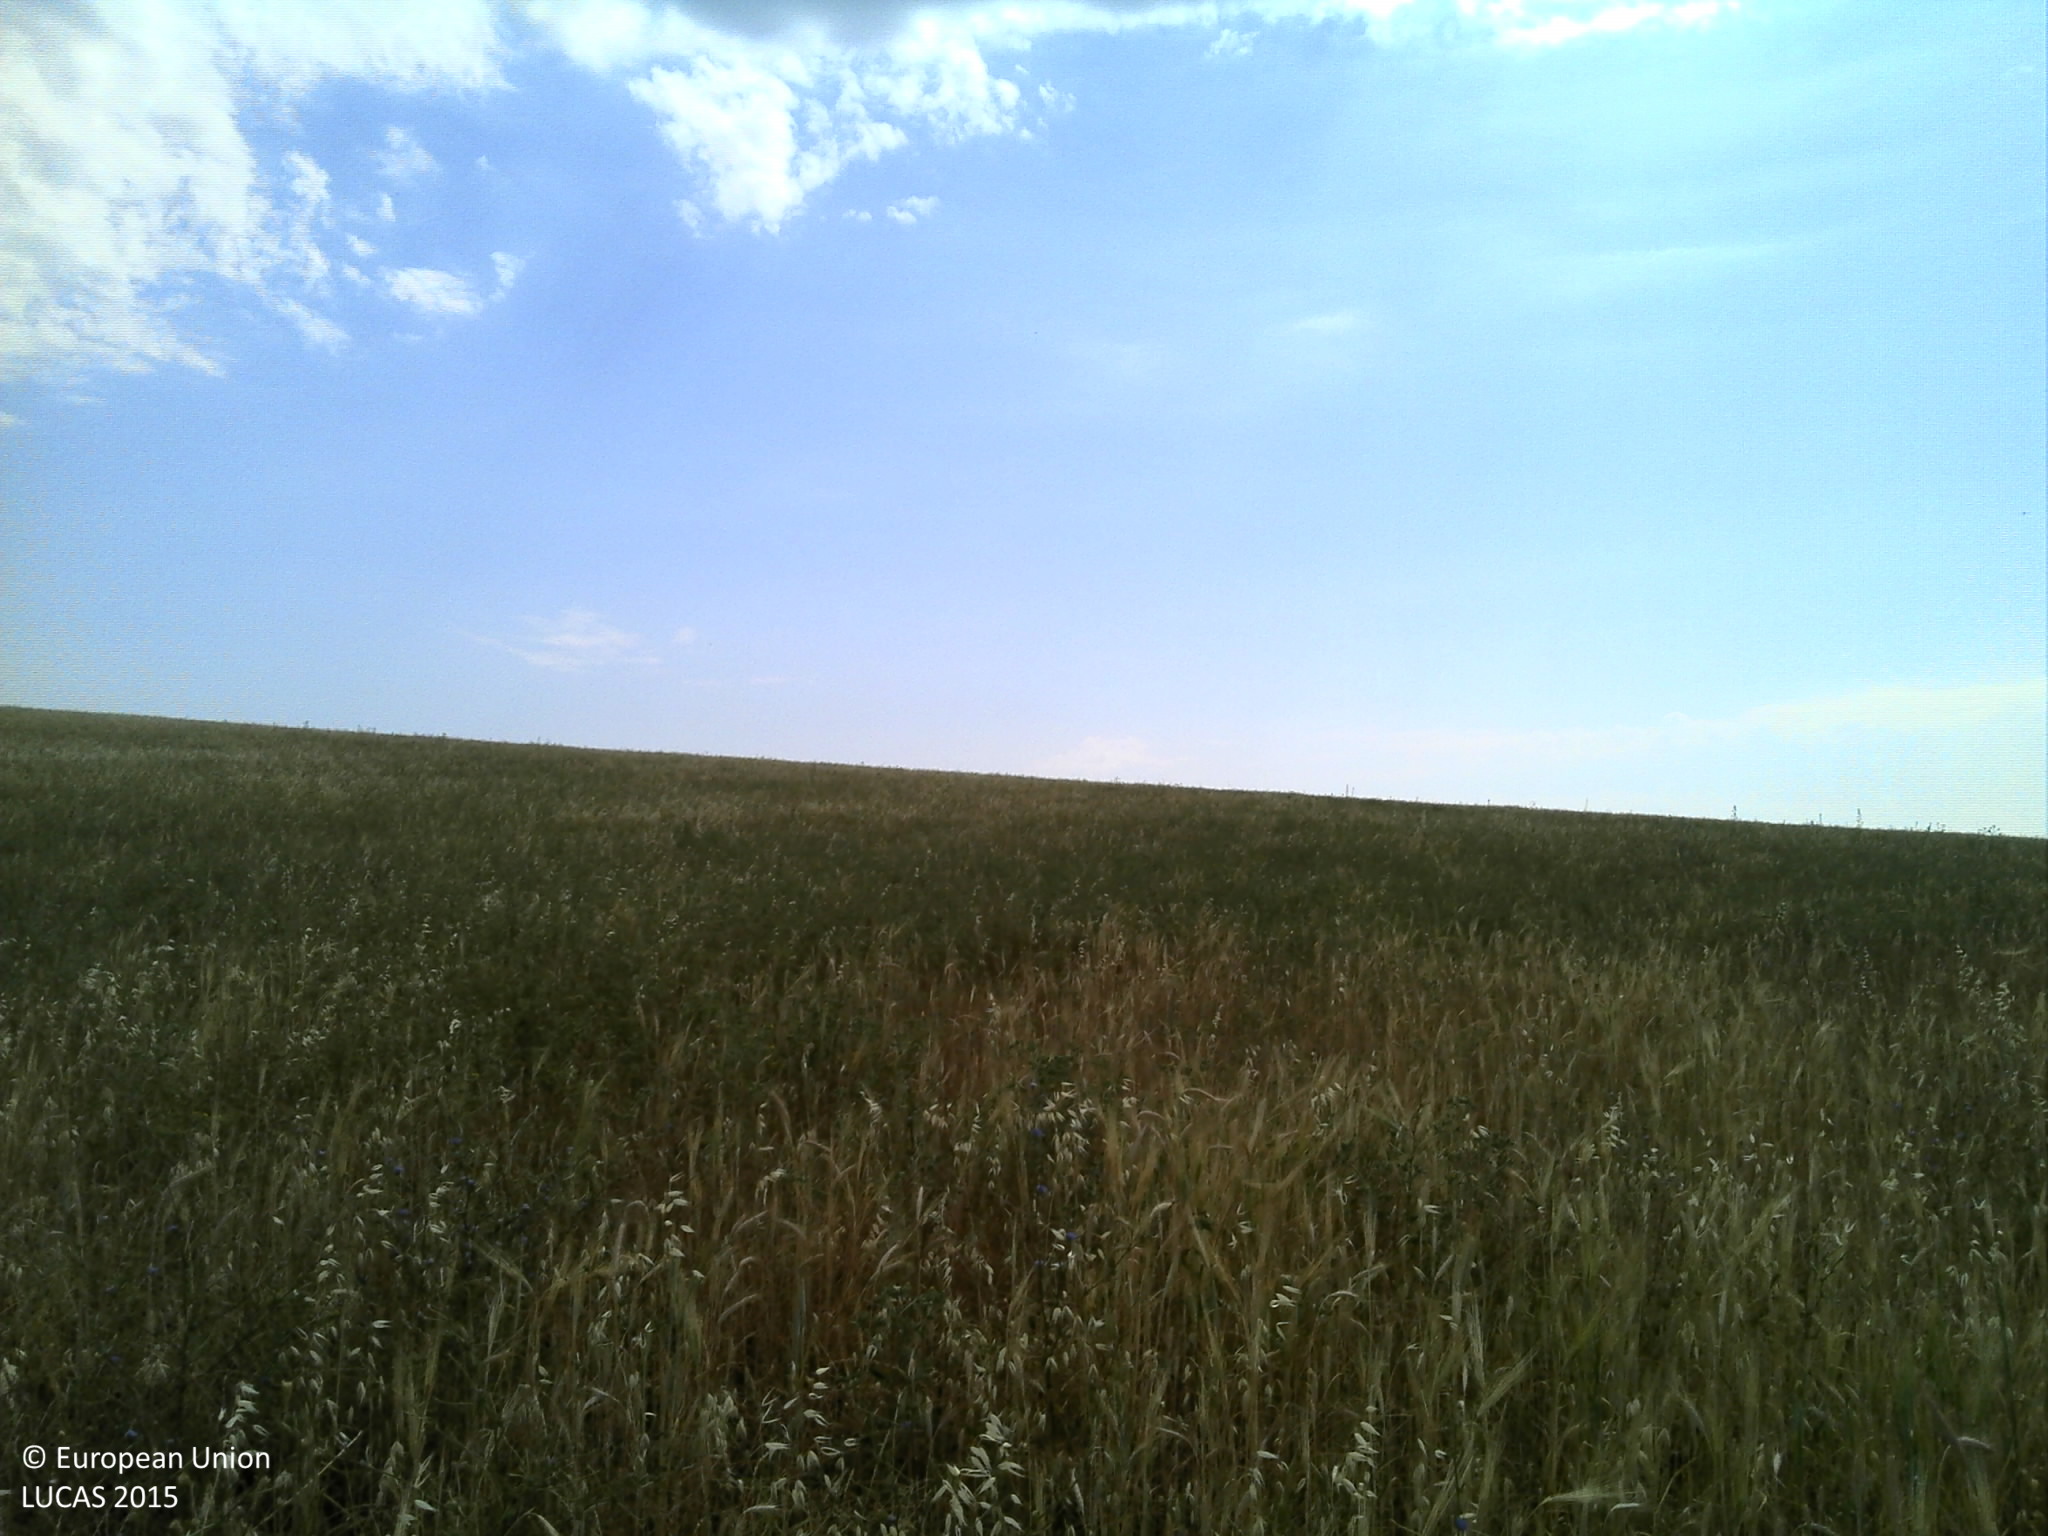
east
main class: Cropland
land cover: Triticale
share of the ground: > 75 %
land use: Agriculture (excluding fallow land and kitchen gardens)
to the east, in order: Triticale
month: May
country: PT
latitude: 38.8828
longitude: -7.9017
